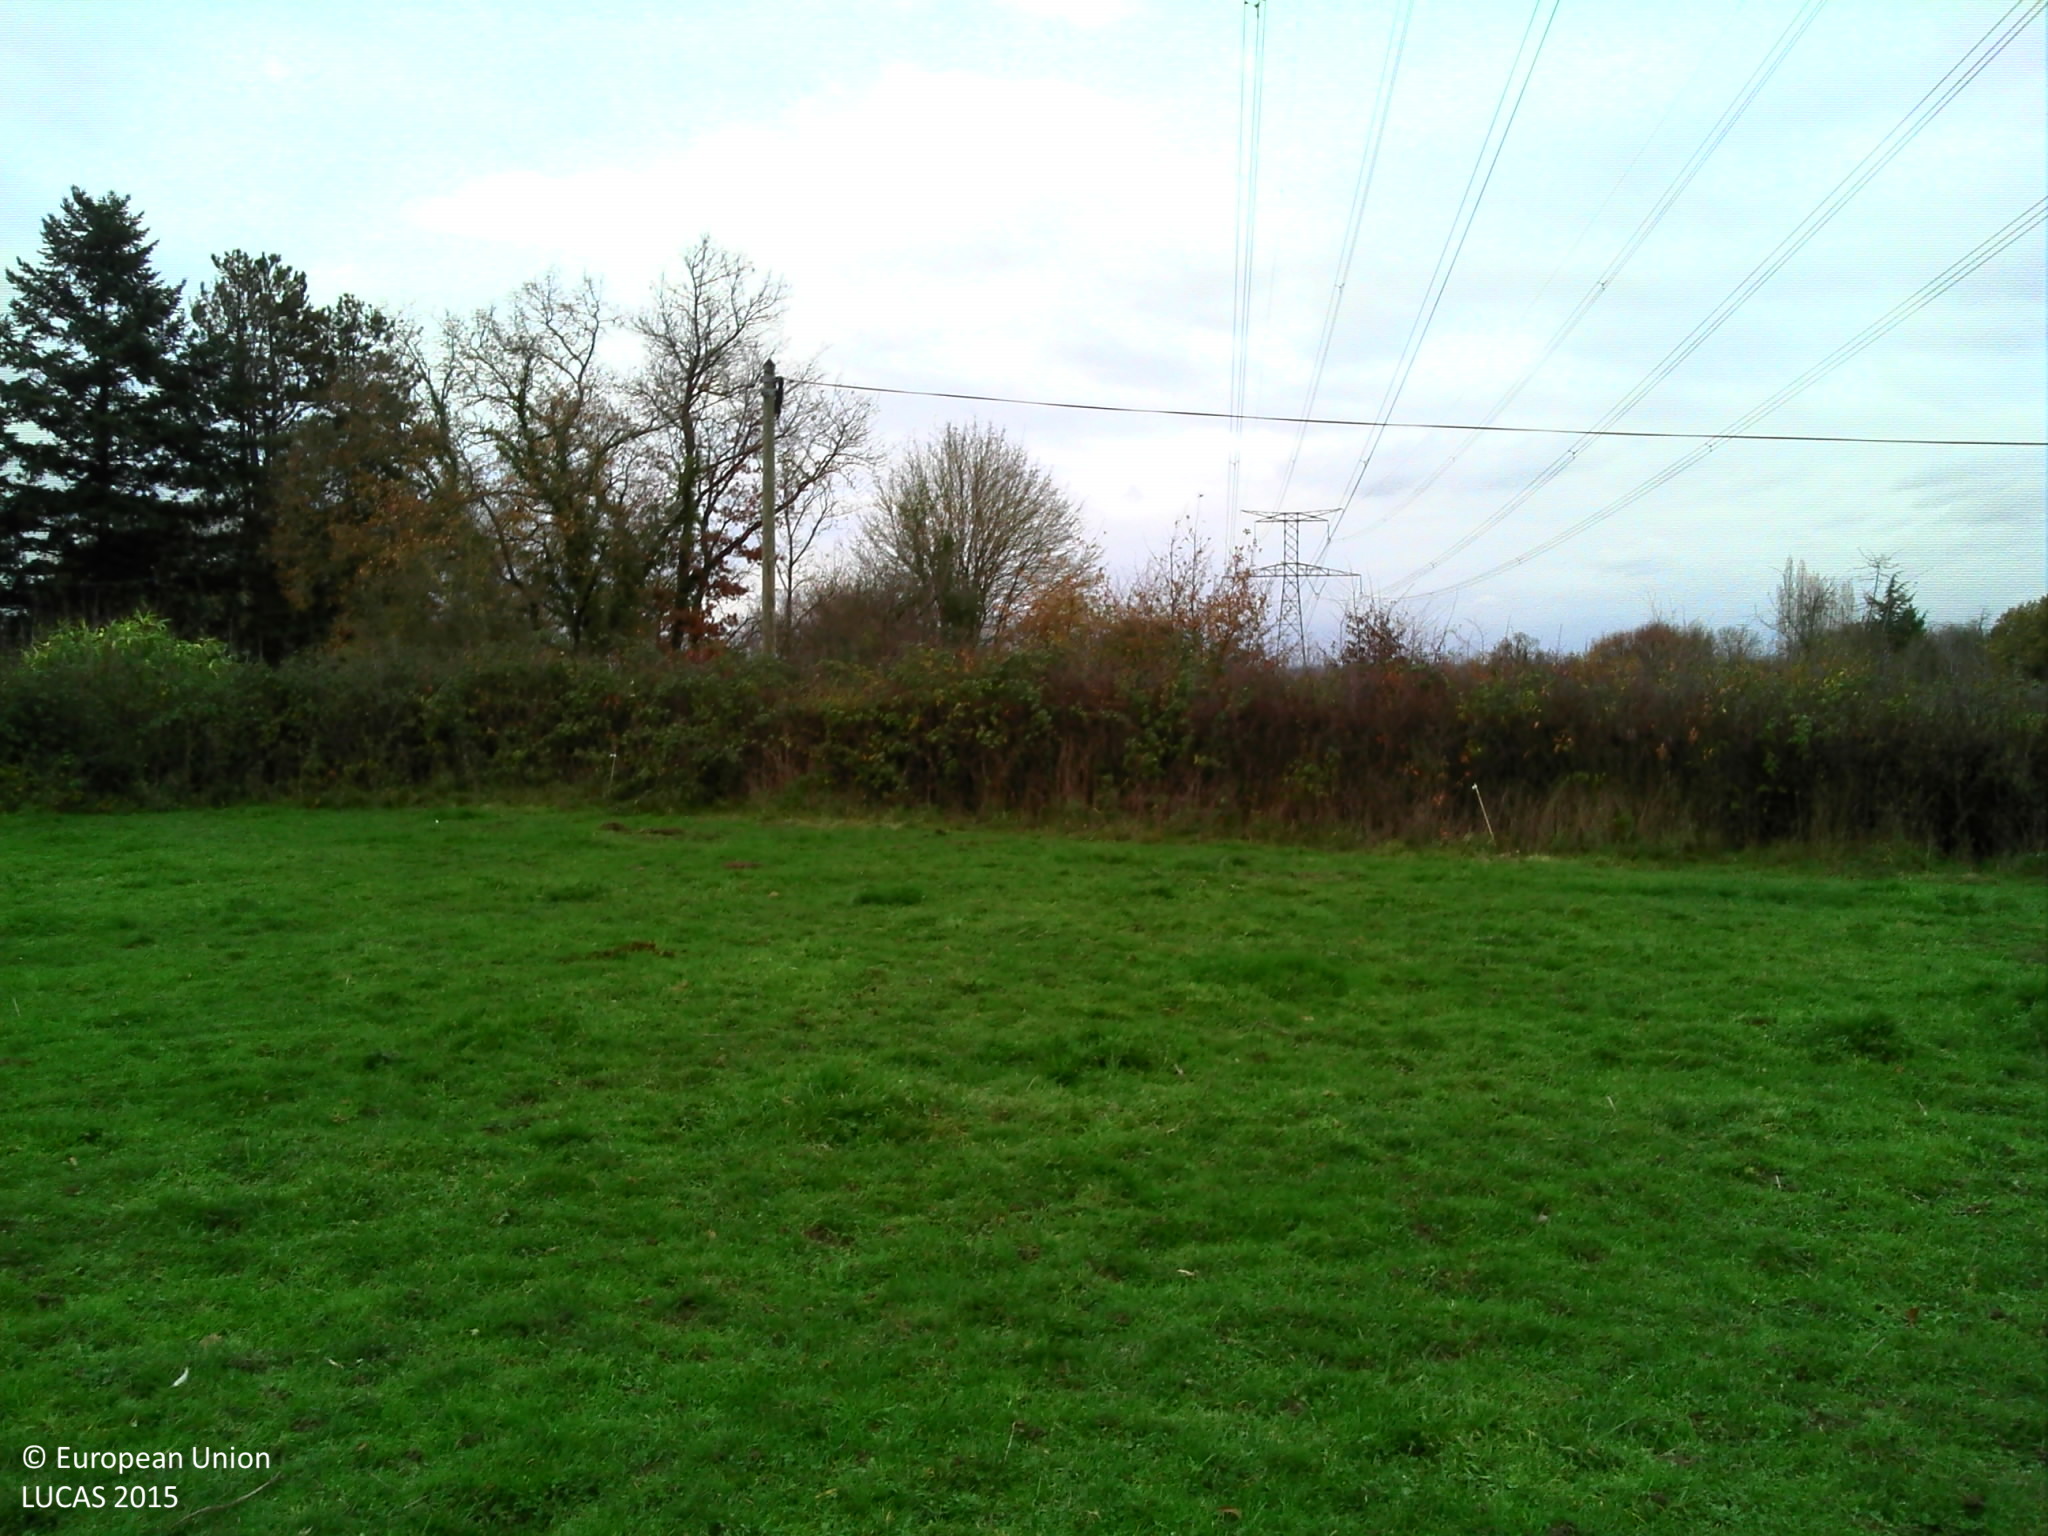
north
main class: Grassland
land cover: Grassland without tree/shrub cover
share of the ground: > 75 %
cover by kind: herbaceous plants 100 %
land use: Agriculture (excluding fallow land and kitchen gardens)
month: November
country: FR
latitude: 46.6418
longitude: 3.2172
